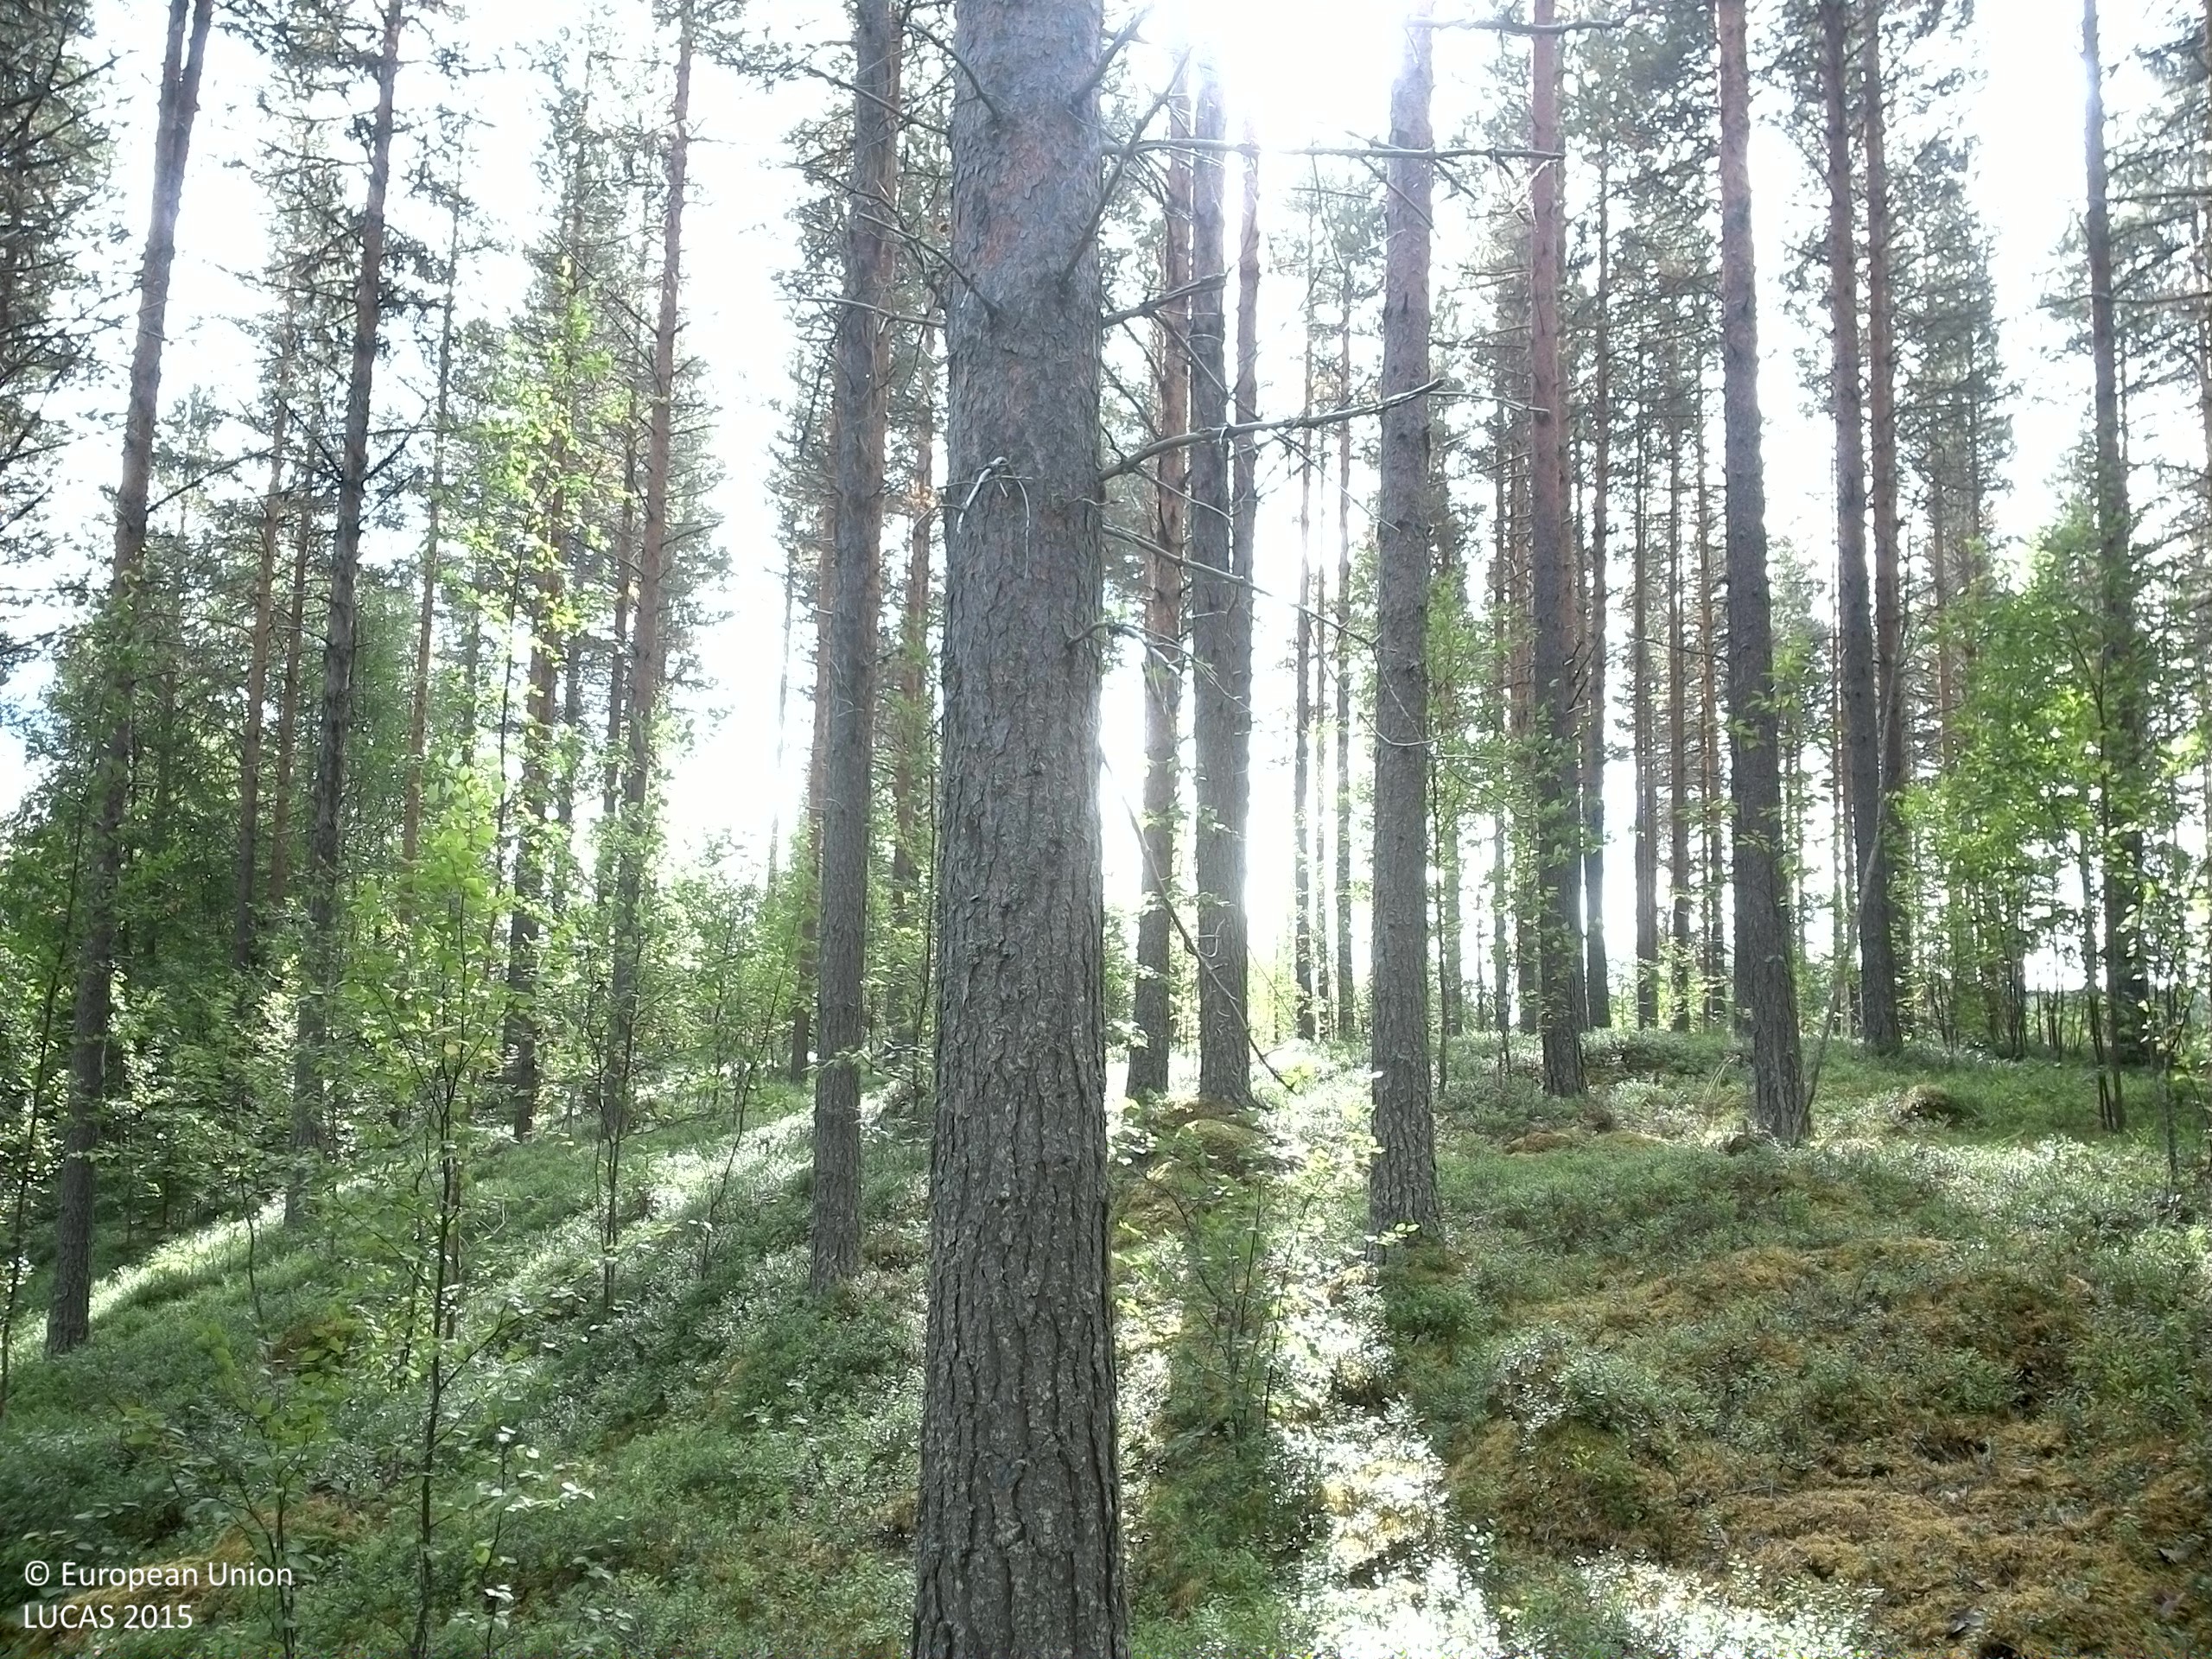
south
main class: Woodland
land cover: Pine dominated coniferous woodland
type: boreal forest
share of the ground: 50 - 75 %
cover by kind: coniferous forest trees 60 %, shrubs 25 %, lichens and mosses 10 %, broadleaved forest trees 5 %
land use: Forestry
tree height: > 5 m
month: September
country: SE
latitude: 64.1533
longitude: 17.3912
